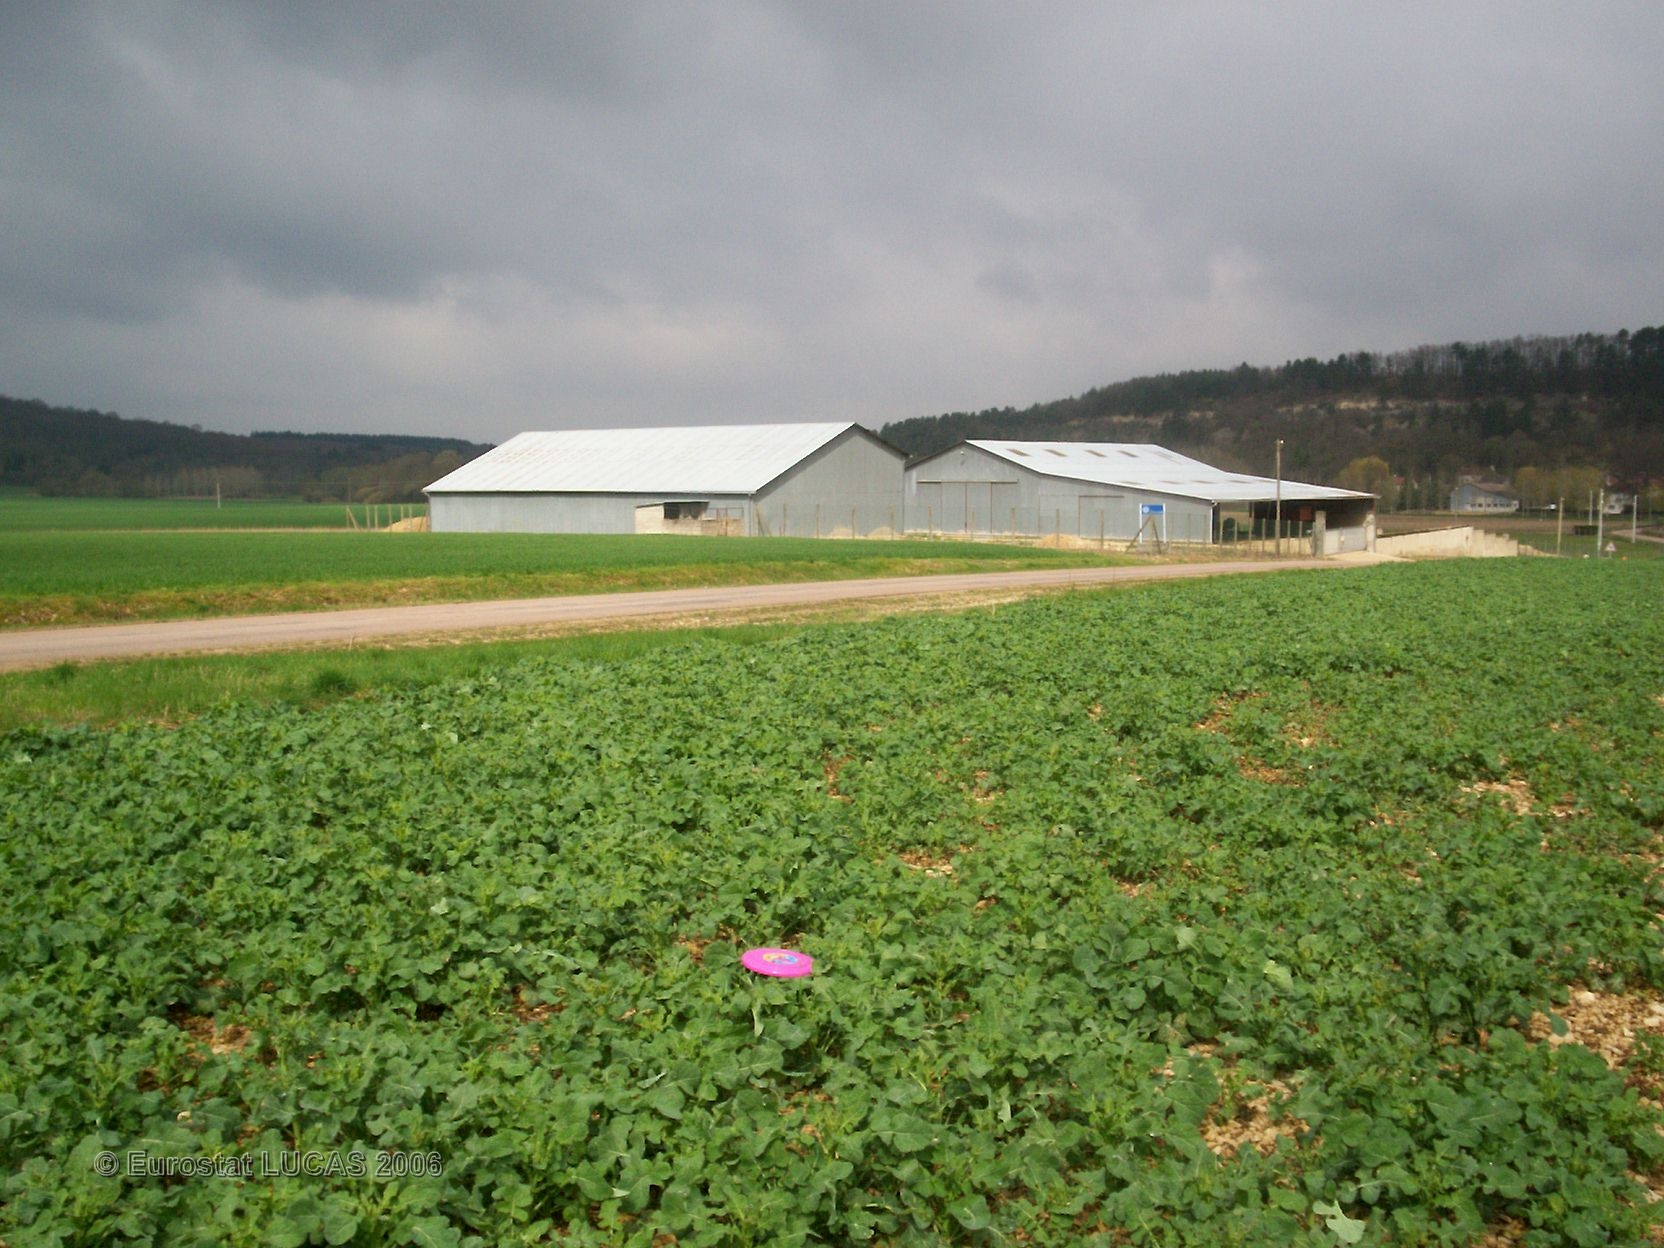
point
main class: Cropland
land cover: Rape and turnip rape
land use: Agriculture (excluding fallow land and kitchen gardens)
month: April
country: FR
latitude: 48.0355
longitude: 4.5664
